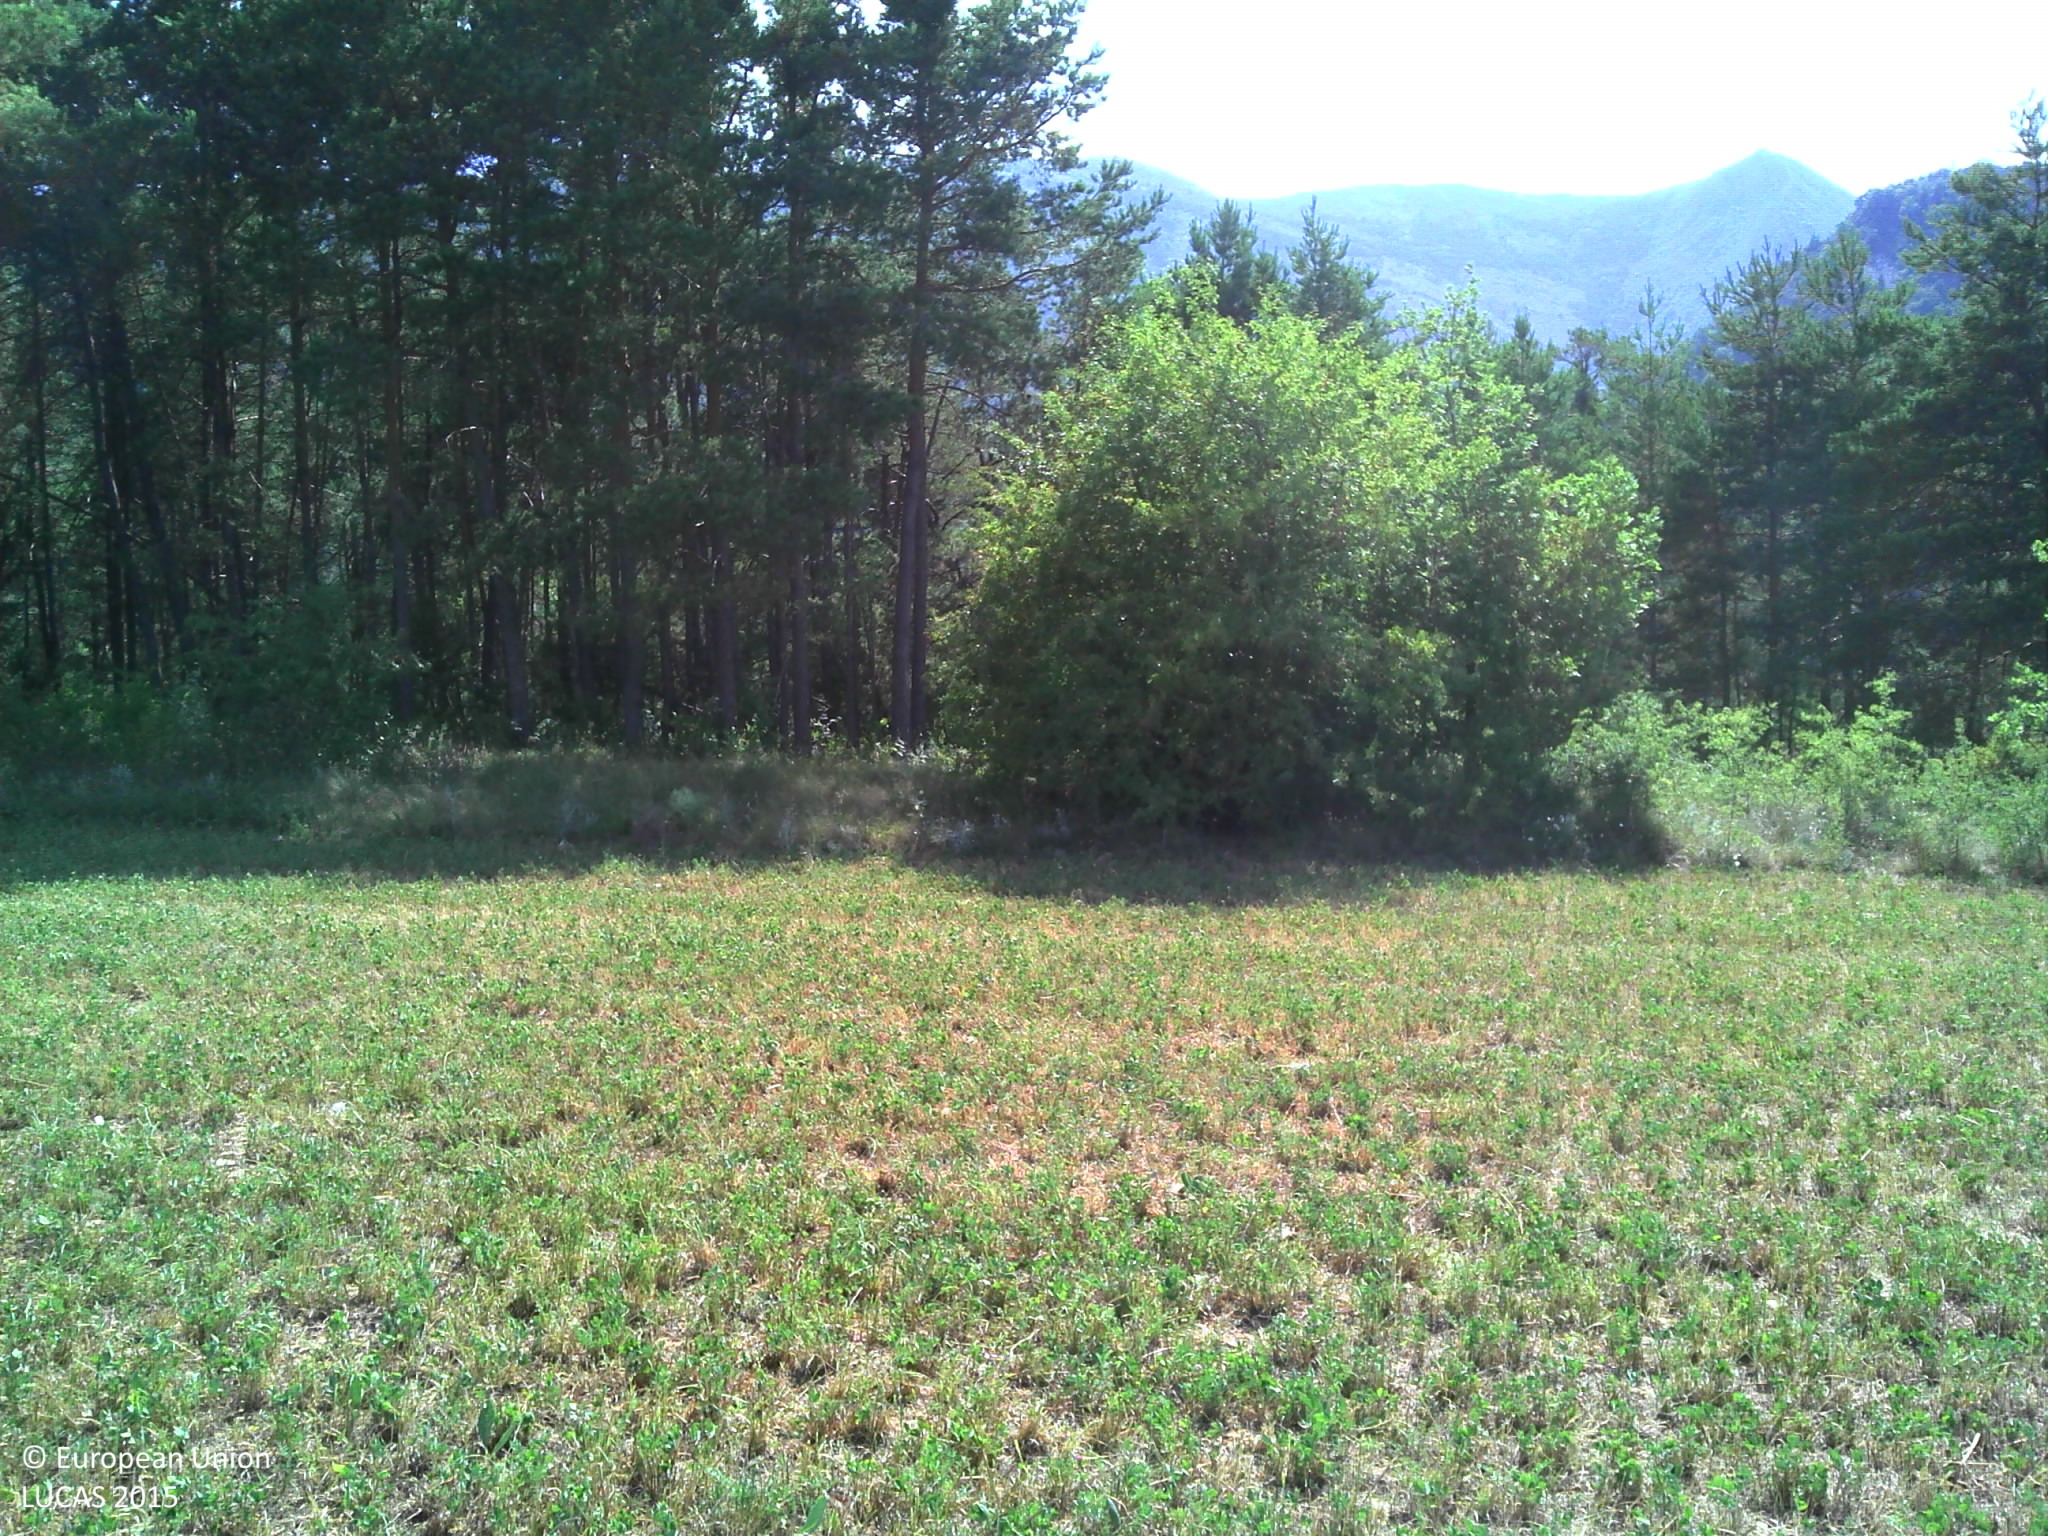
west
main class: Cropland
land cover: Temporary grasslands
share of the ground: > 75 %
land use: Agriculture (excluding fallow land and kitchen gardens)
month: July
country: FR
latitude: 43.9093
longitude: 6.4091
